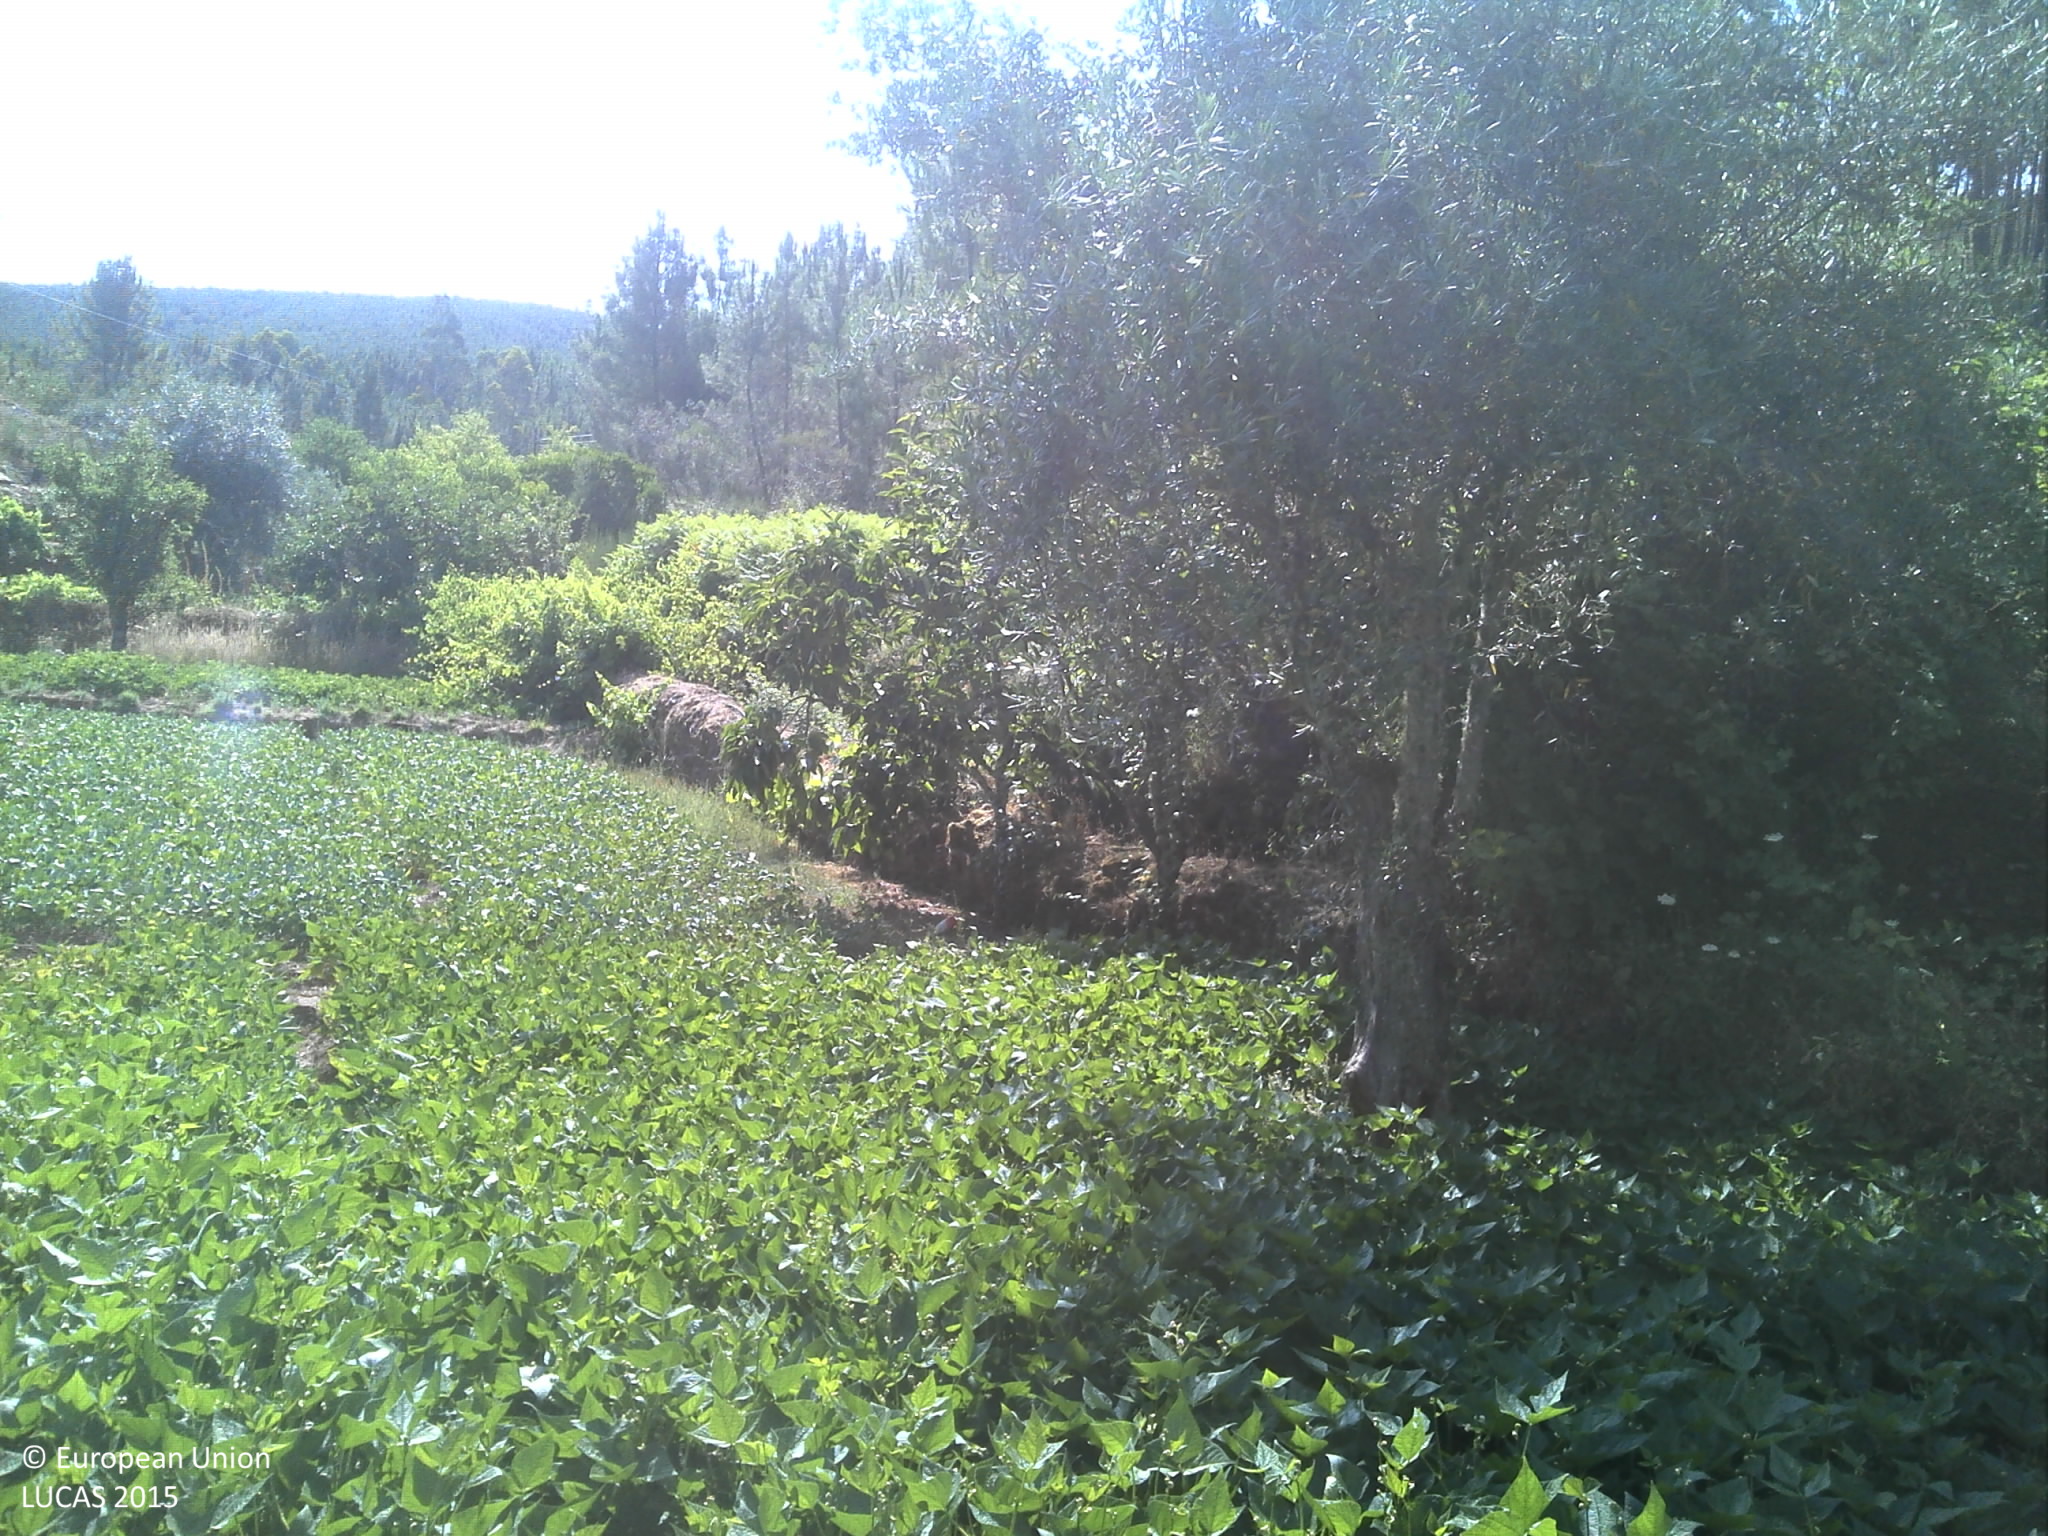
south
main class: Woodland
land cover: Pine dominated coniferous woodland
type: coniferous forest of the mediterranean region
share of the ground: 25 - 50 %
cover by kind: shrubs 60 %, coniferous forest trees 35 %, unconsolidated bare surface 5 %
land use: Forestry
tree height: > 5 m
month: July
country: PT
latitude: 40.0993
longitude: -7.7167
